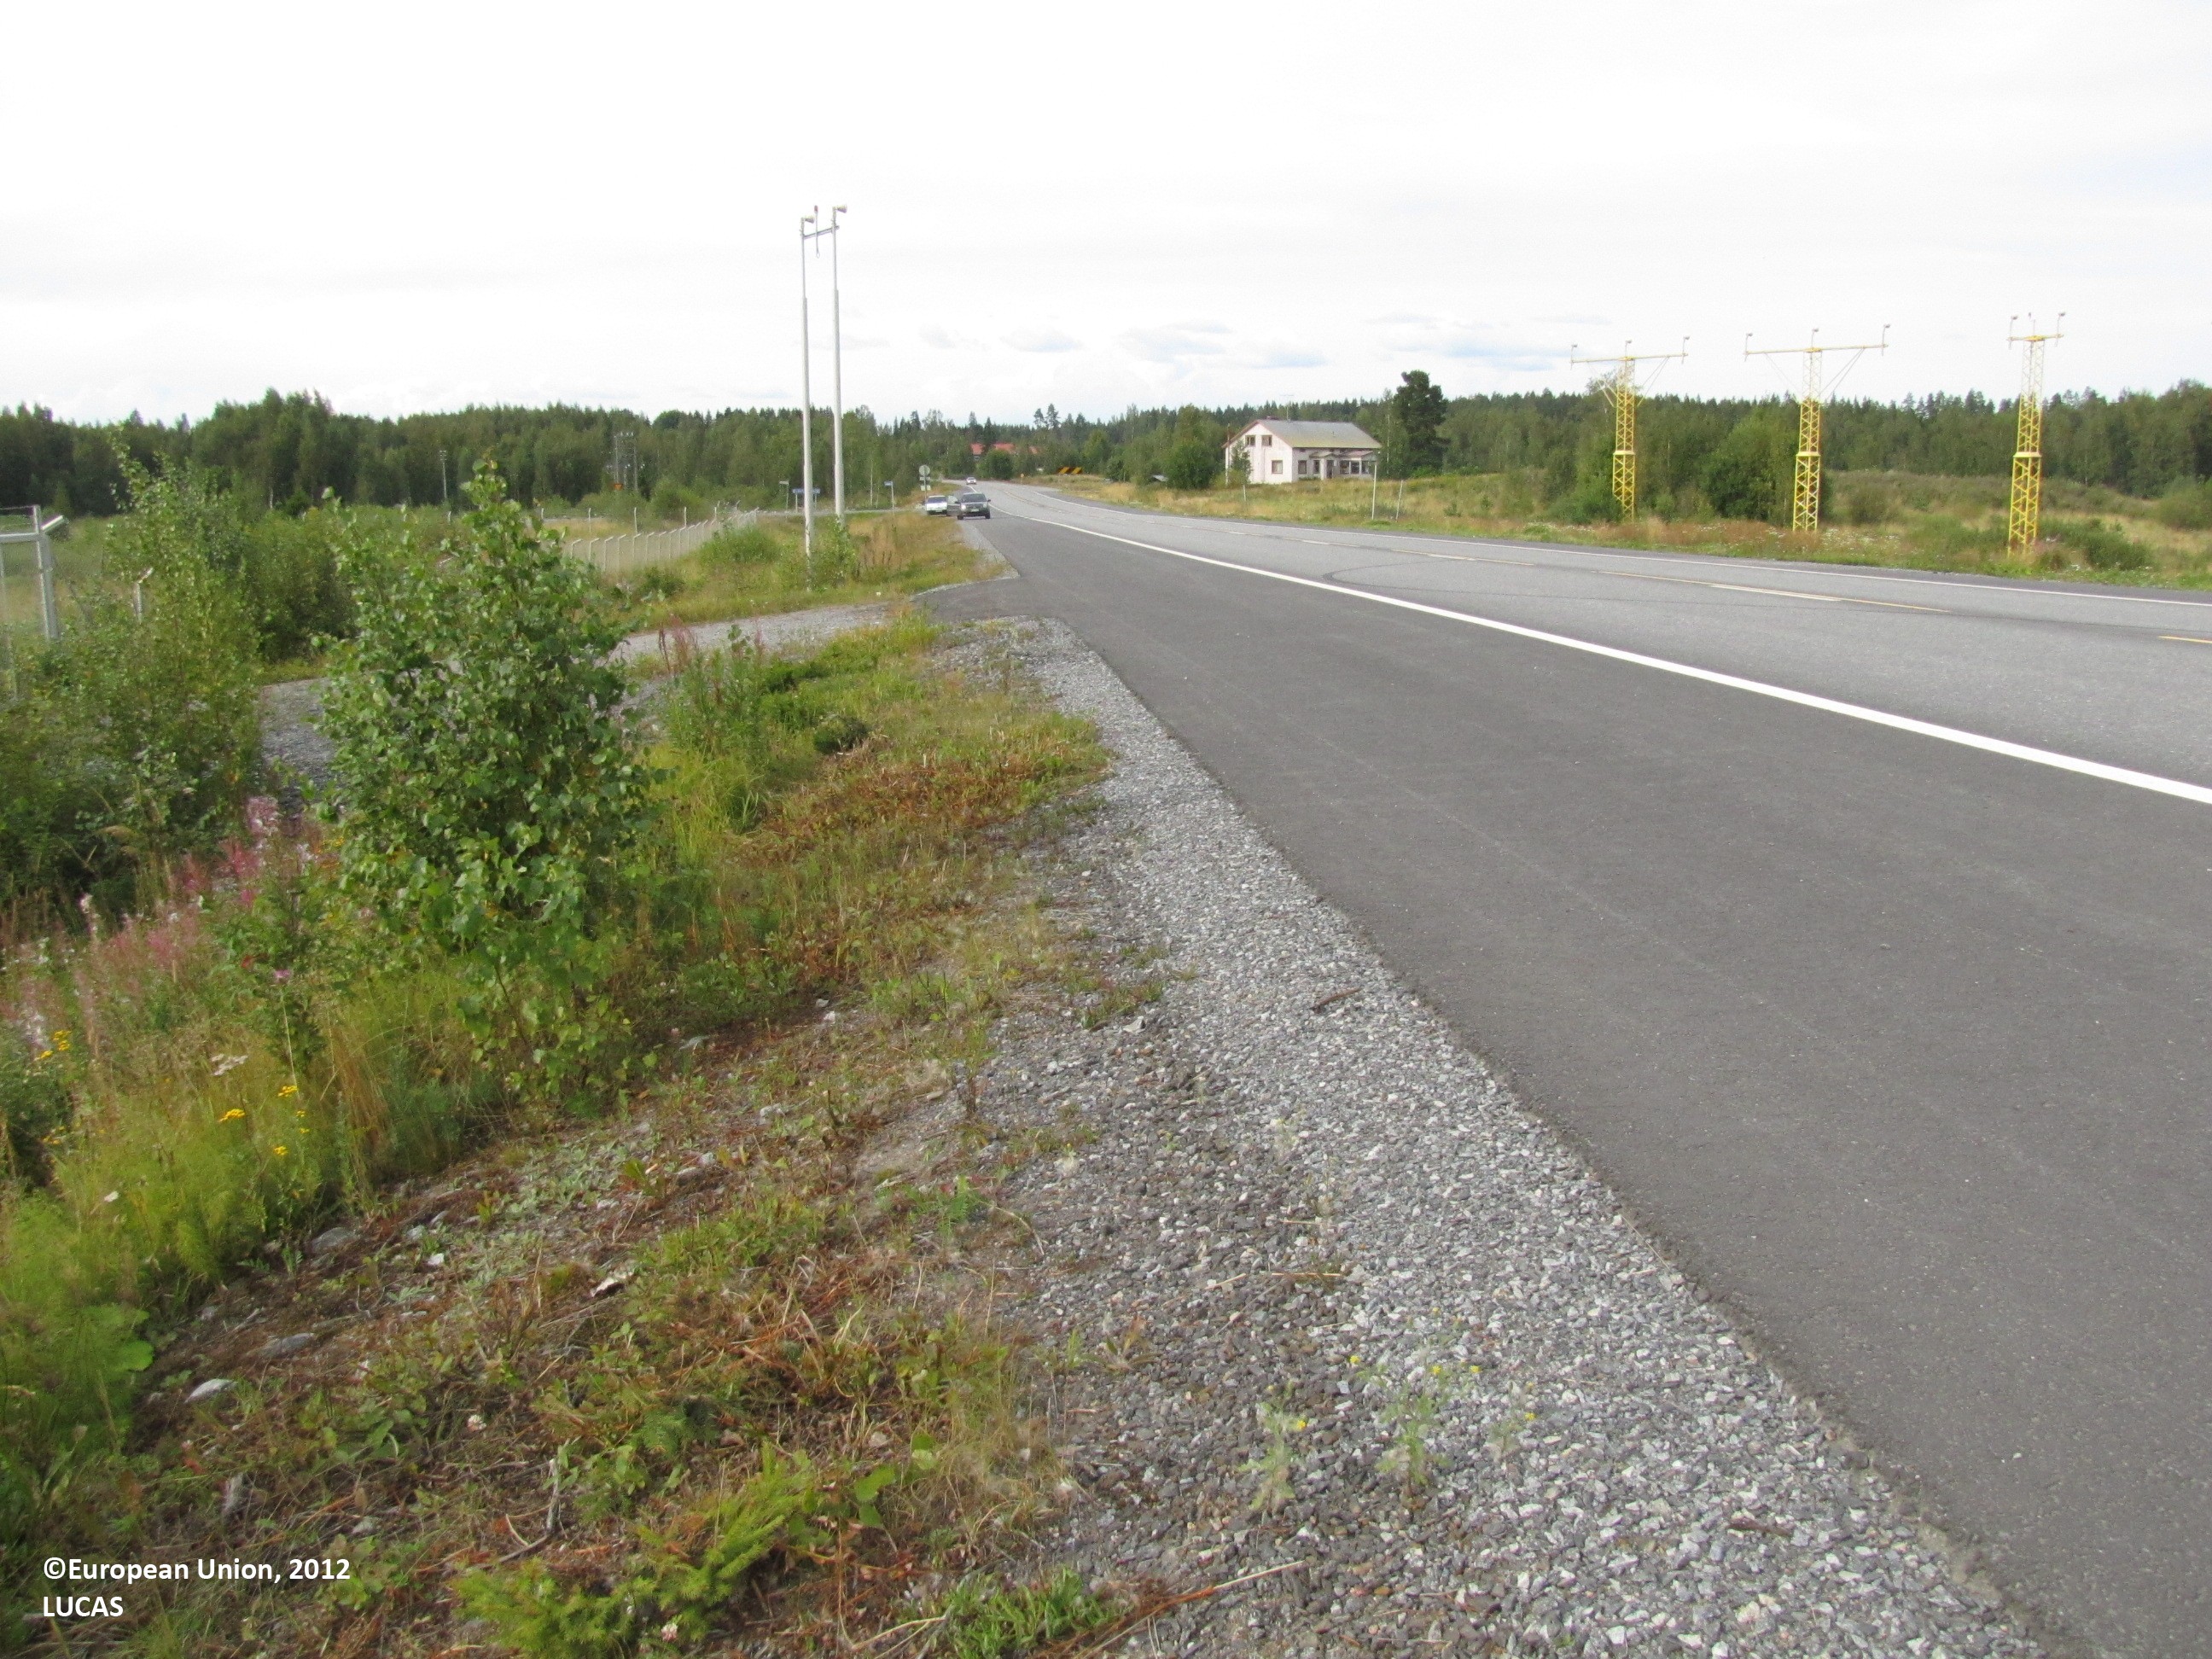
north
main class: Grassland
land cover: Grassland without tree/shrub cover
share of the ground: > 75 %
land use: Air transport
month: August
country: FI
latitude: 61.4201
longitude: 23.6304
